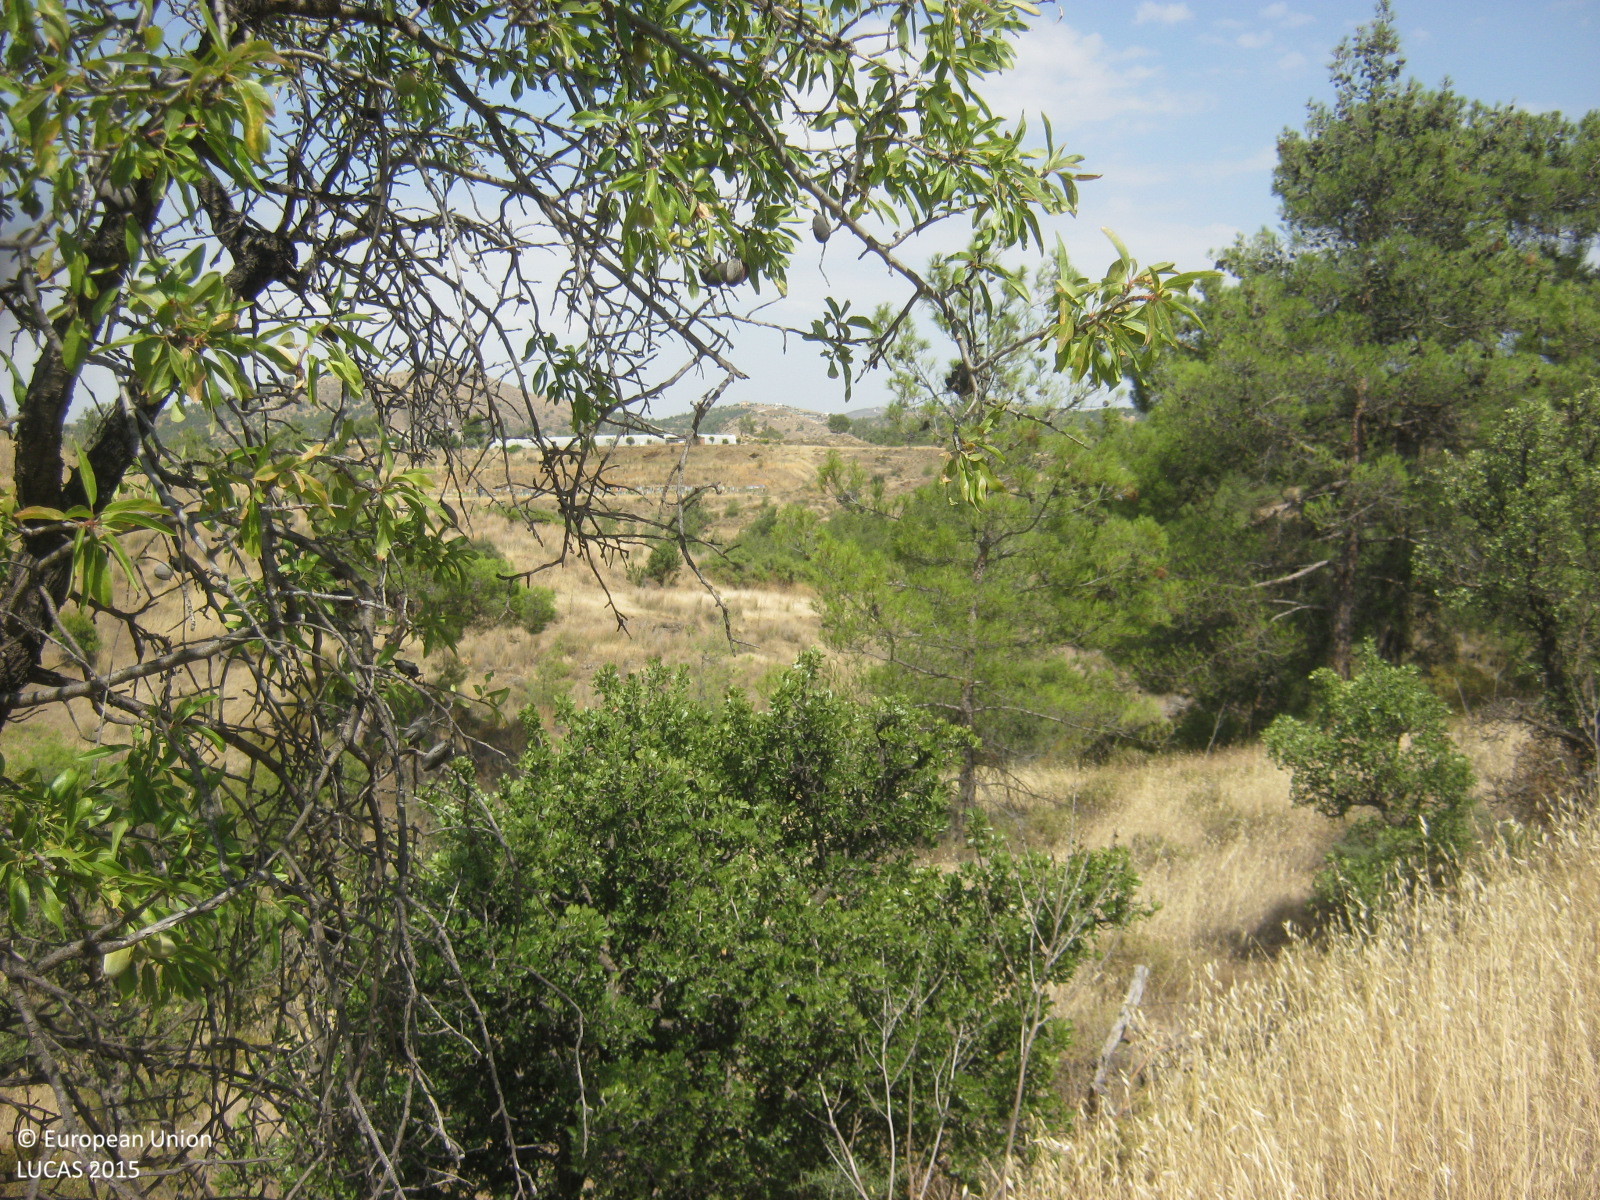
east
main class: Cropland
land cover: Nuts trees
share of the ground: 25 - 50 %
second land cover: Grassland without tree/shrub cover
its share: > 75 %
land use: Agriculture (excluding fallow land and kitchen gardens)
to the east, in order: Nuts trees; Grassland without tree/shrub cover; Grassland with sparse tree/shrub cover; Rivers and streams; Grassland with sparse tree/shrub cover; Pine dominated coniferous woodland; Grassland with sparse tree/shrub cover; Pine dominated coniferous woodland
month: June
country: CY
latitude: 35.0530
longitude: 33.0138
